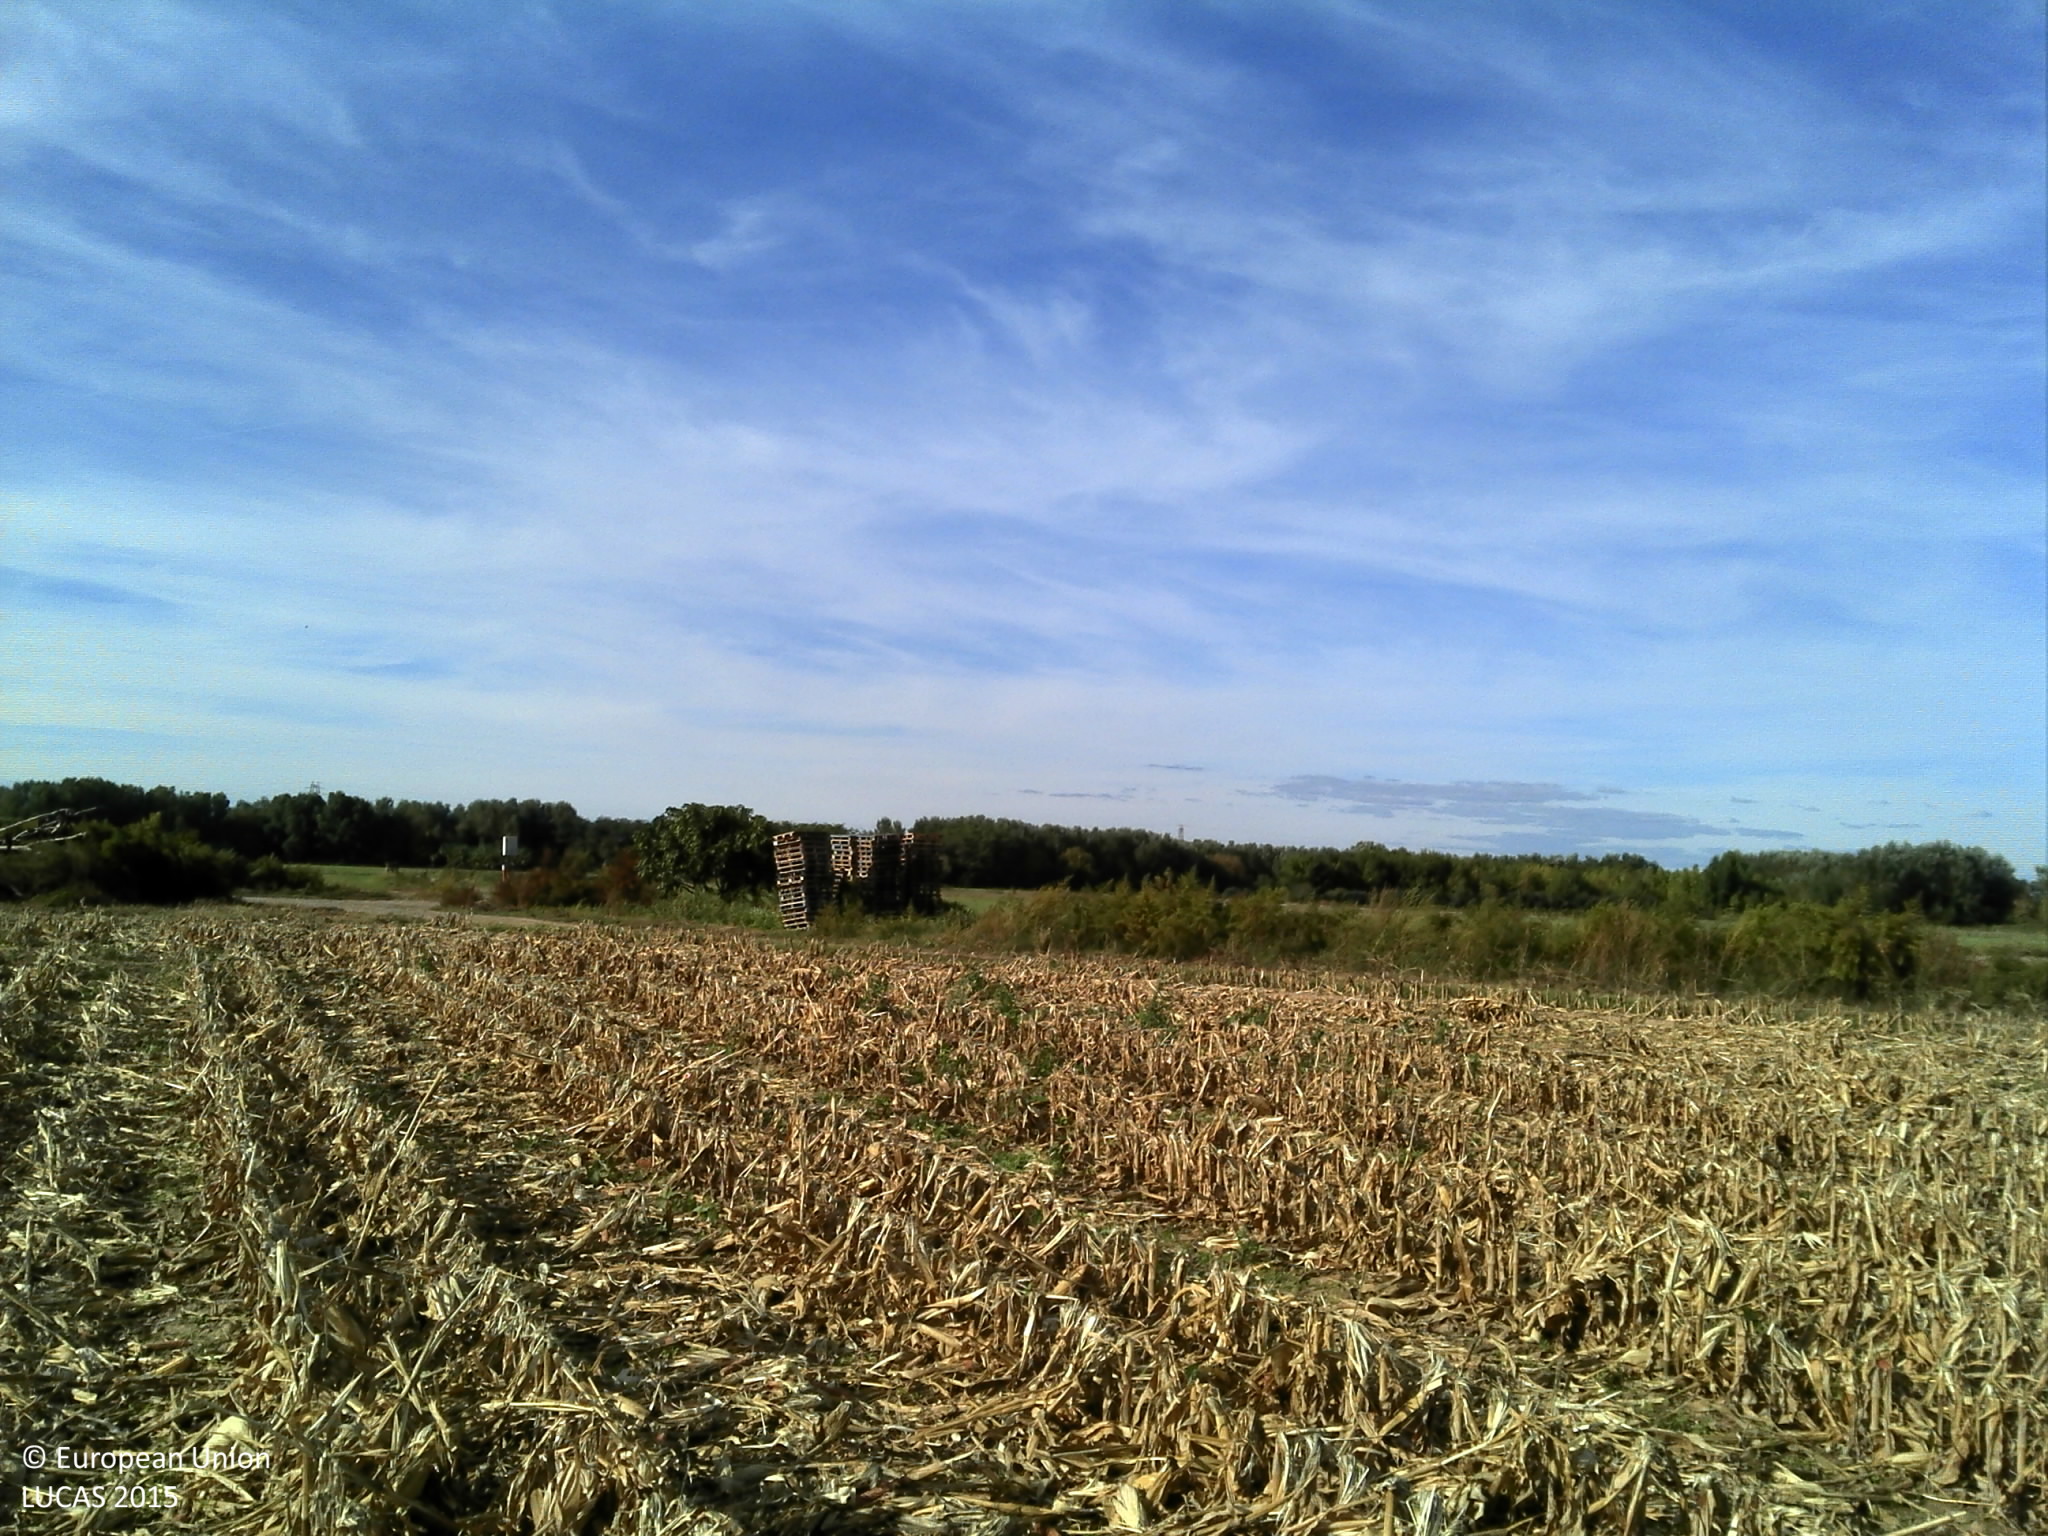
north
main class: Cropland
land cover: Maize
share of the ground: 50 - 75 %
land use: Agriculture (excluding fallow land and kitchen gardens)
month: October
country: FR
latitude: 43.4002
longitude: 3.4285
